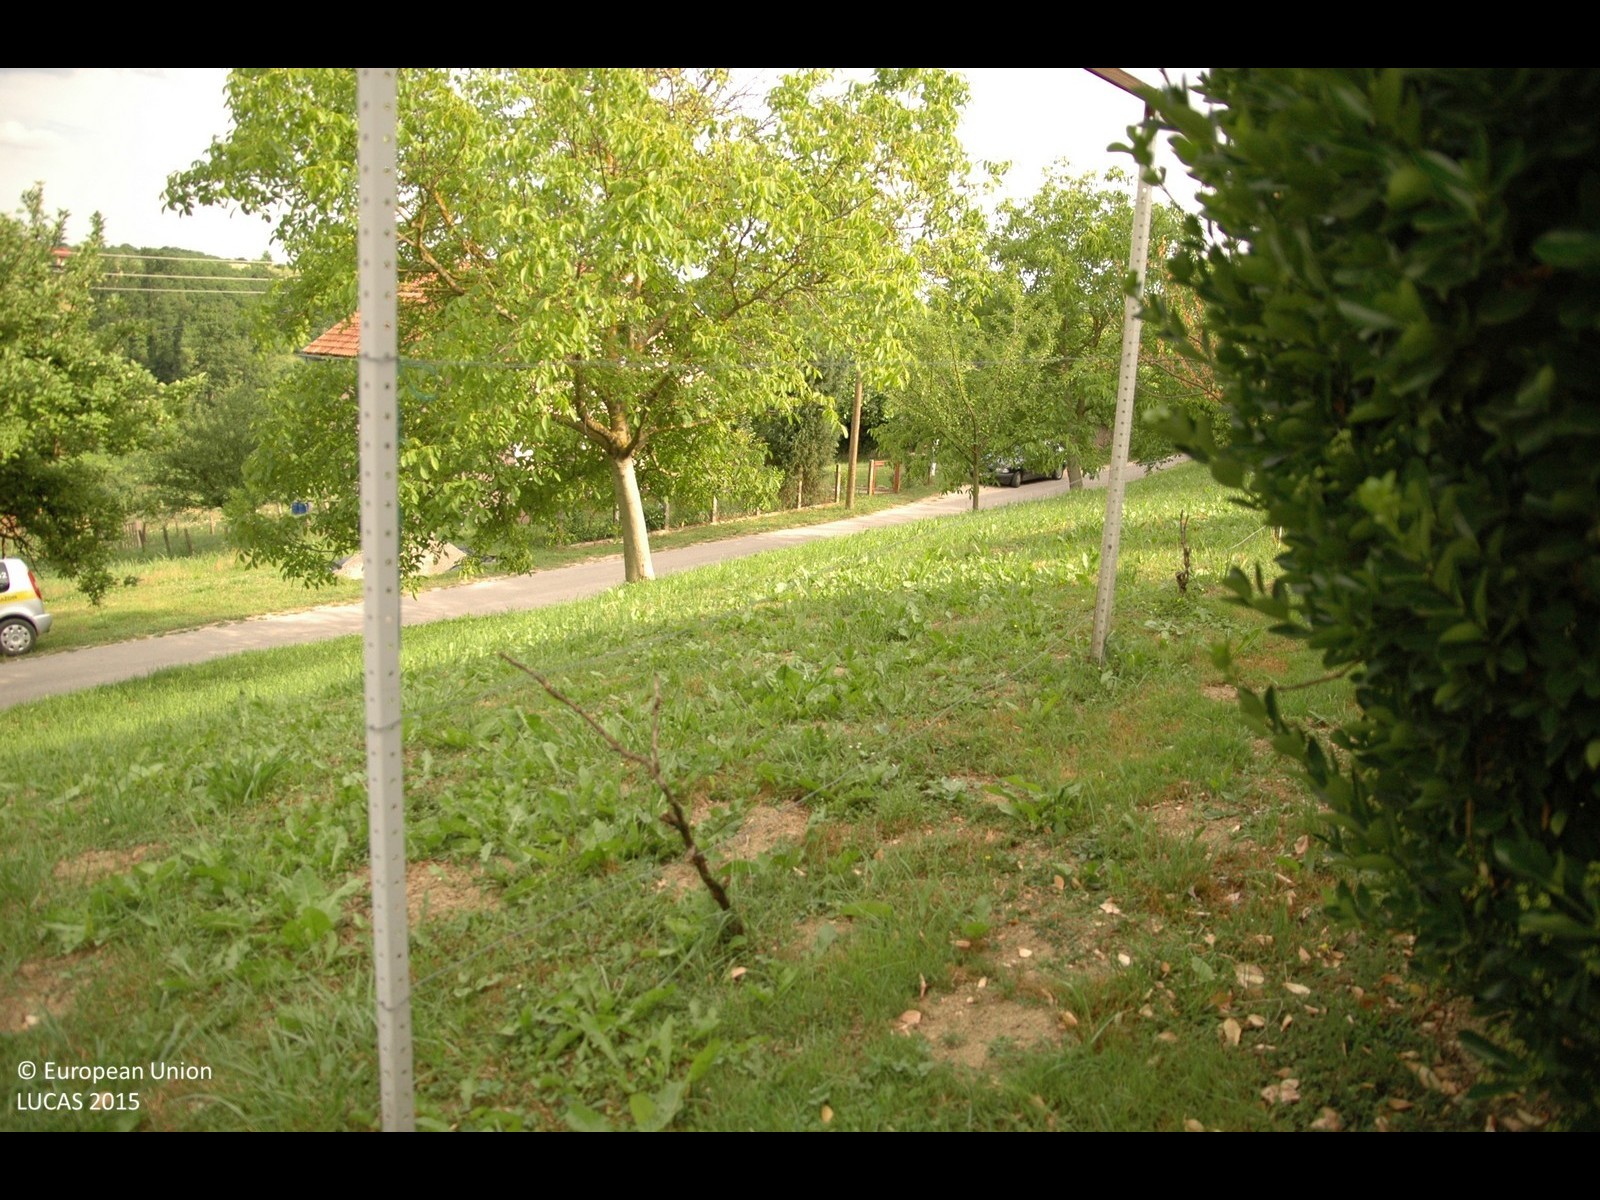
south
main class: Grassland
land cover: Grassland without tree/shrub cover
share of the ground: > 75 %
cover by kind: herbaceous plants 100 %
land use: Residential
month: June
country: HR
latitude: 46.1651
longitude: 16.3068
